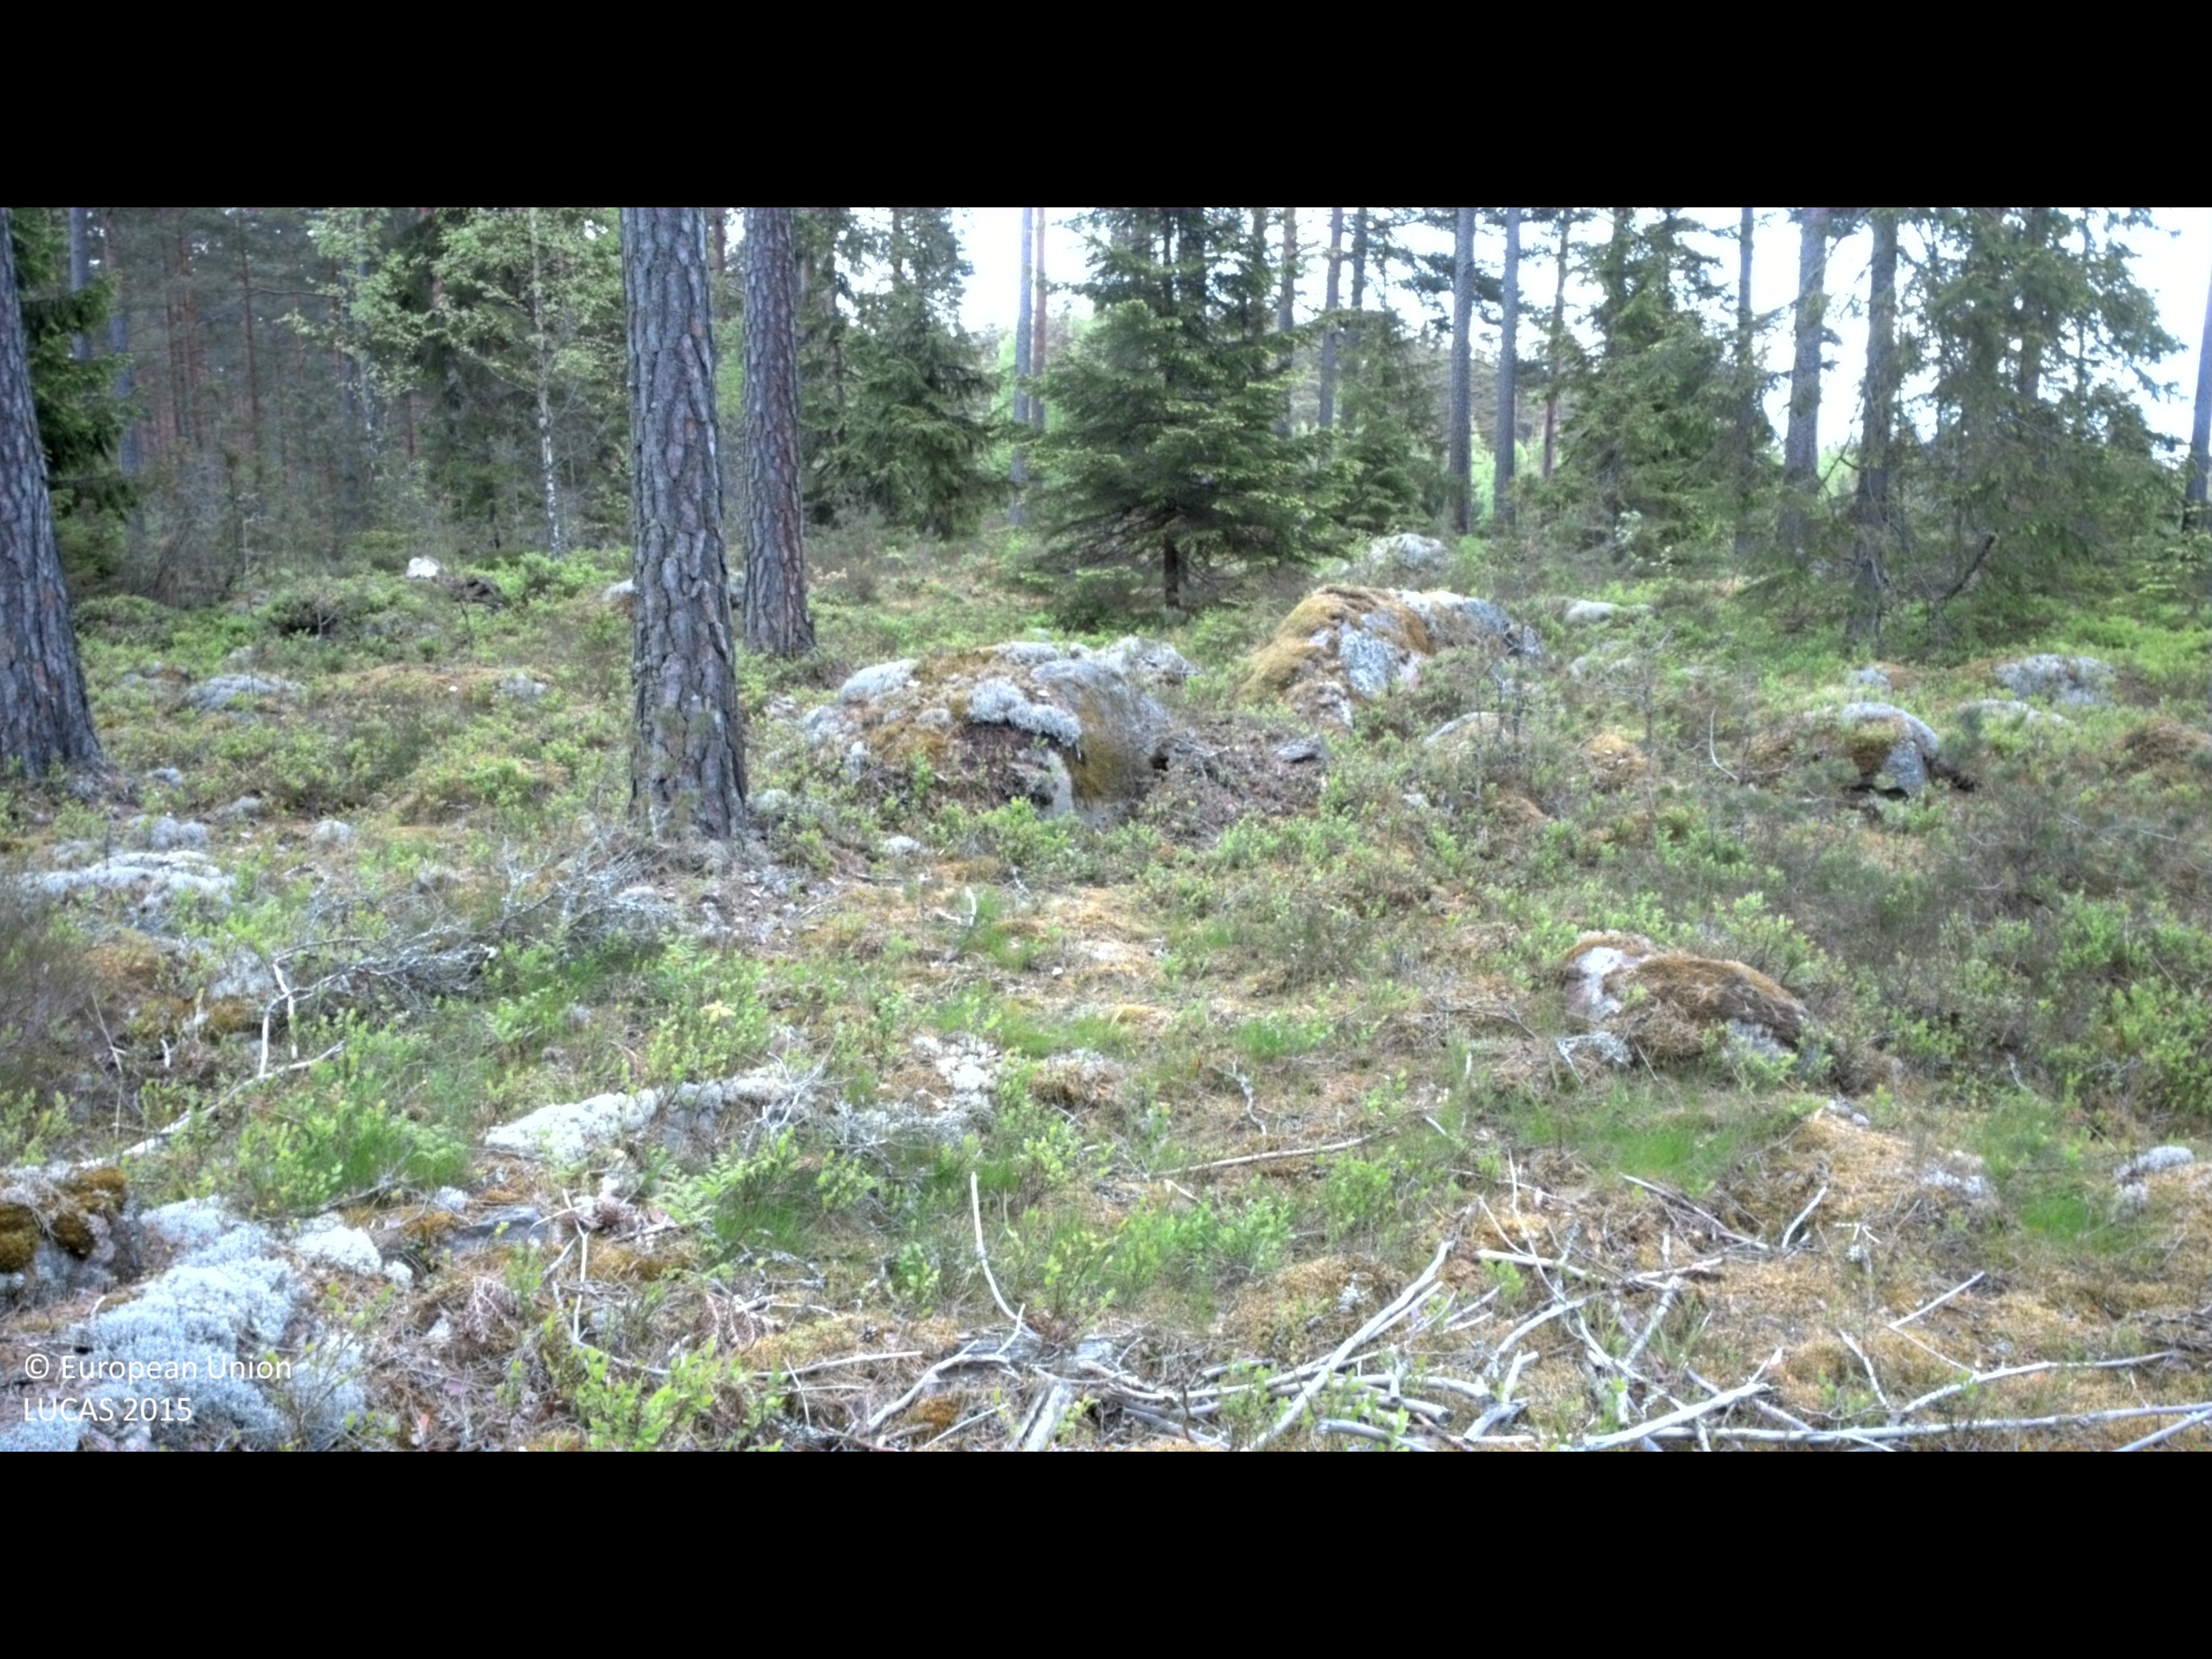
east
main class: Woodland
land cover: Pine dominated coniferous woodland
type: boreal forest
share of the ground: 50 - 75 %
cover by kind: coniferous forest trees 60 %, shrubs 30 %, broadleaved forest trees 5 %, lichens and mosses 5 %
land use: Forestry
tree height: > 5 m
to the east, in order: Pine dominated coniferous woodland; Broadleaved woodland; Pine dominated coniferous woodland
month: May
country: SE
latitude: 57.4295
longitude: 16.1441
